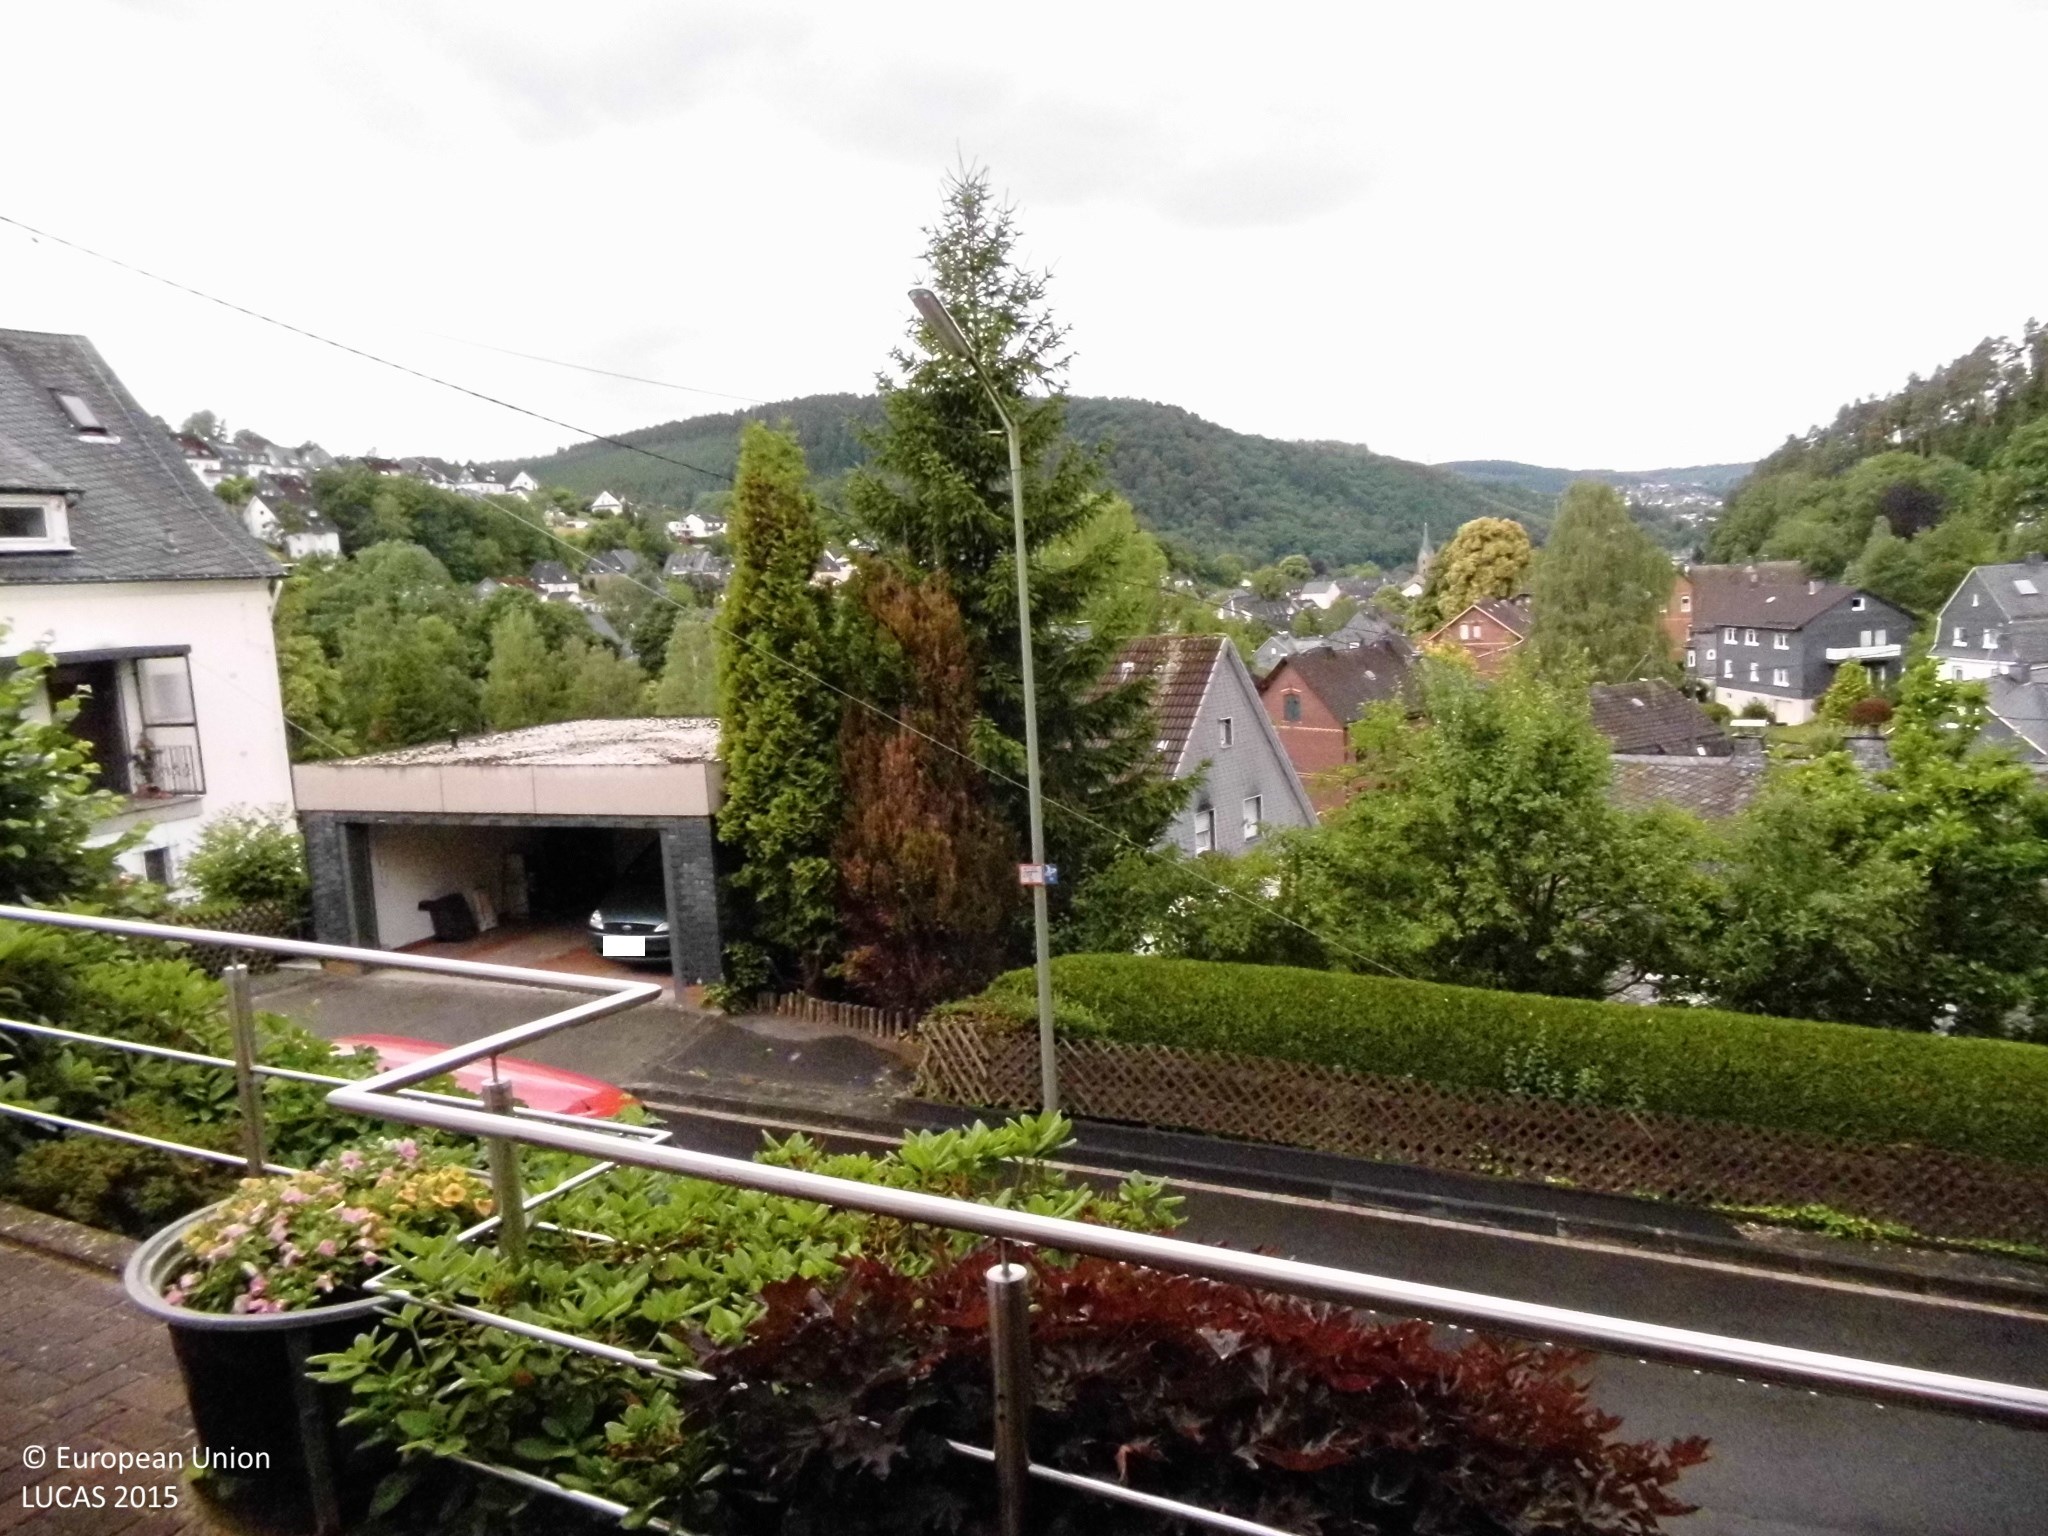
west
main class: Woodland
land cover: Broadleaved woodland
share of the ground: > 75 %
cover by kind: broadleaved forest trees 80 %, coniferous forest trees 20 %
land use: Residential
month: July
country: DE
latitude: 50.8322
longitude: 7.9984
